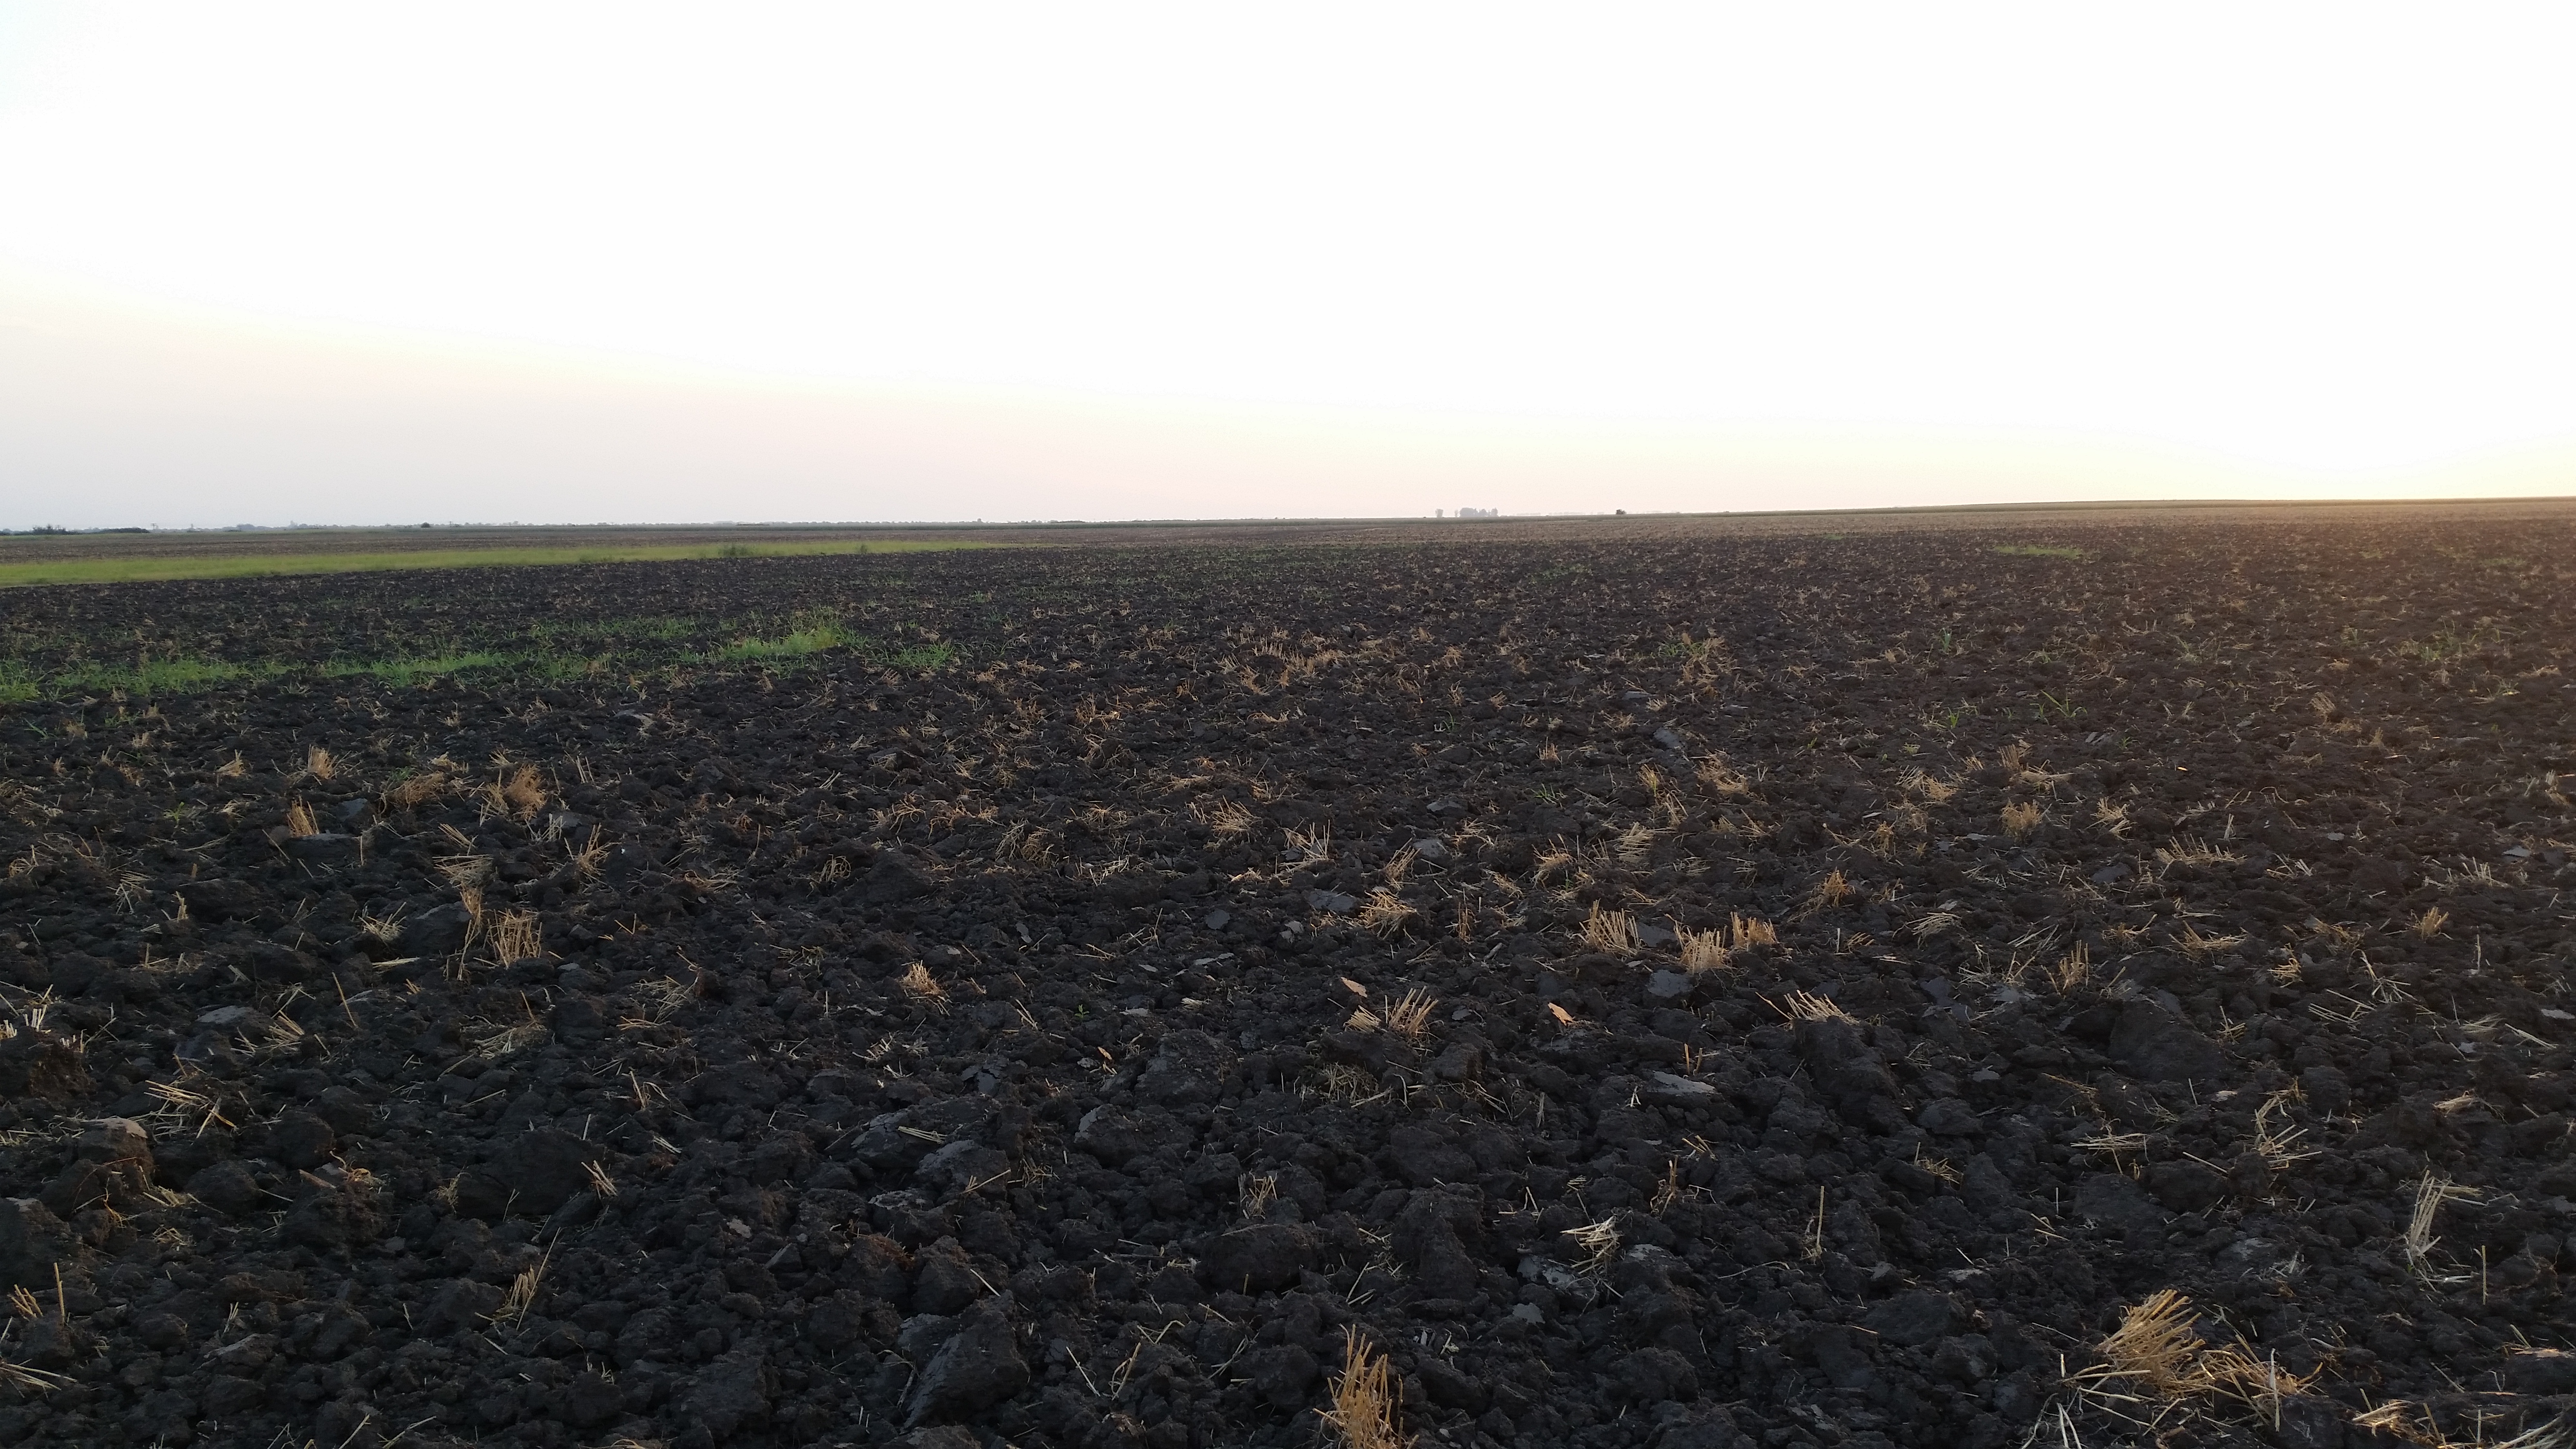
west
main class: Cropland
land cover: Common wheat
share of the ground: < 10 %
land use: Agriculture (excluding fallow land and kitchen gardens)
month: August
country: RO
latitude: 44.0364
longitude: 23.5900
